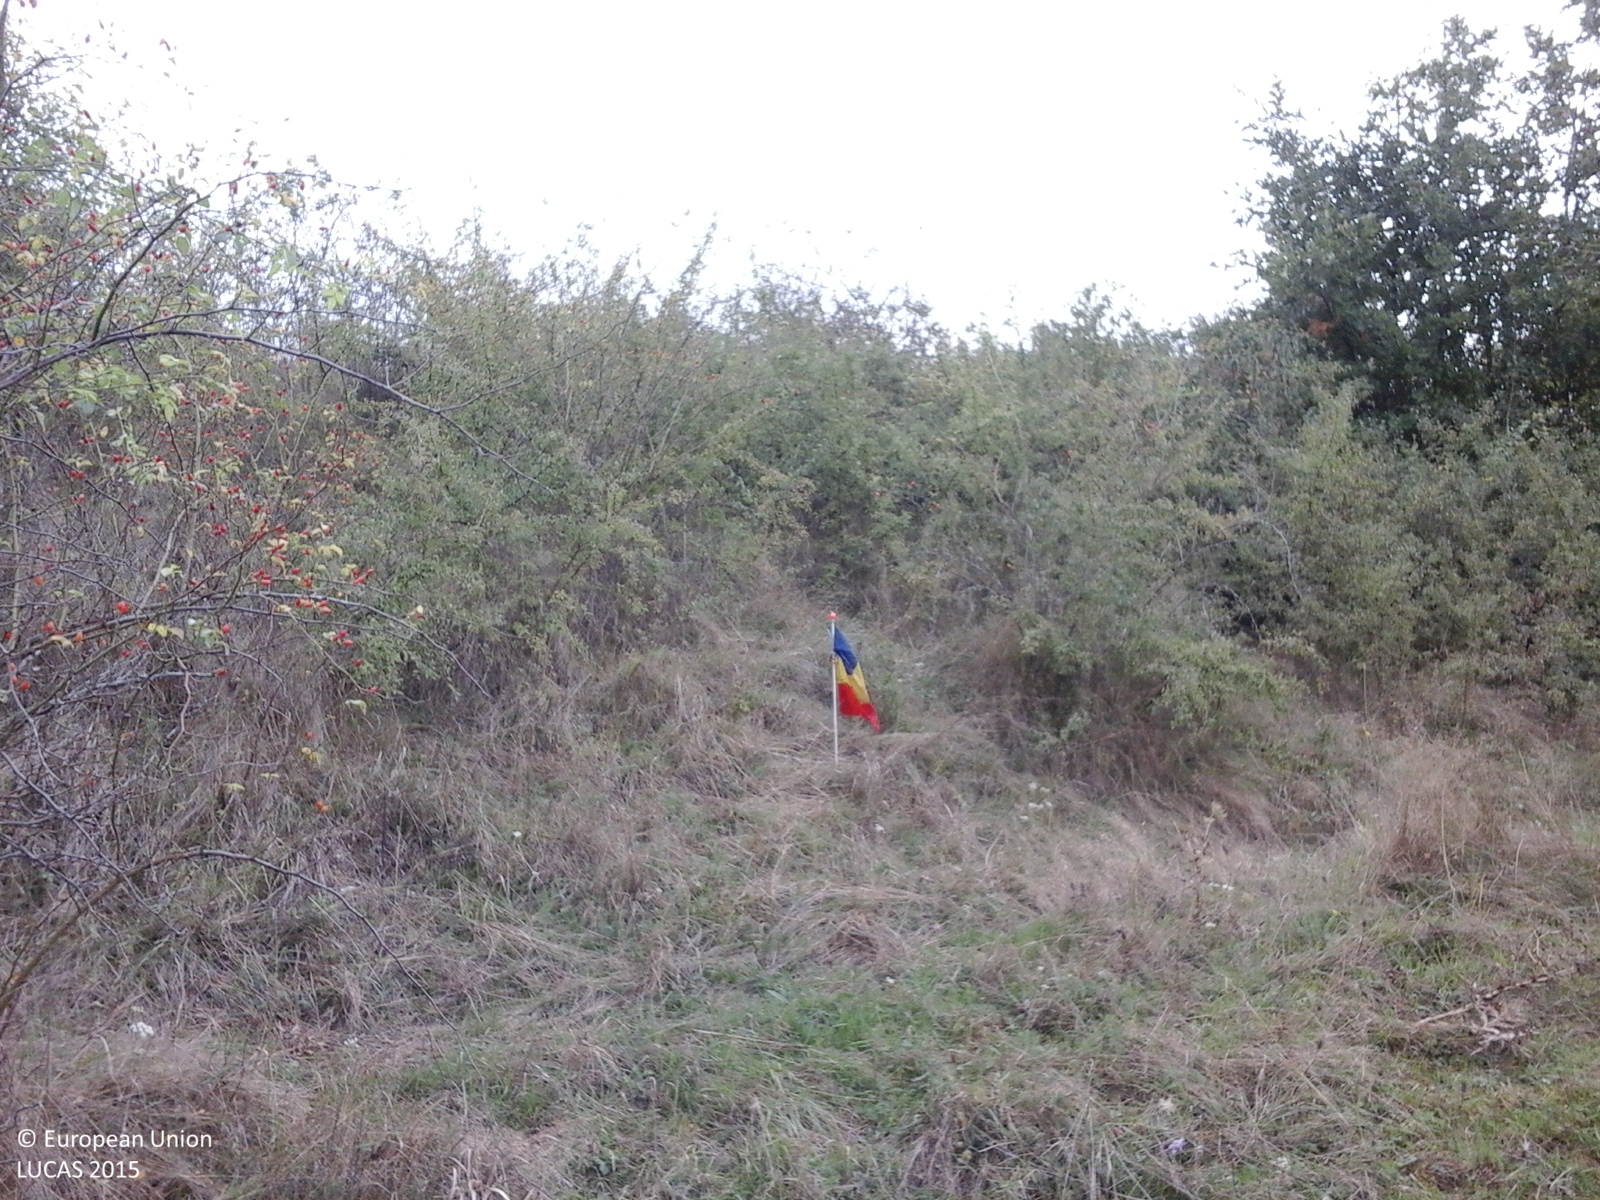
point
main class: Shrubland
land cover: Shrubland with sparse tree cover
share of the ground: > 75 %
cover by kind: herbaceous plants 55 %, shrubs 40 %, broadleaved forest trees 5 %
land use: Fallow land
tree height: < 5 m
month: September
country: RO
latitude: 45.9254
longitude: 22.0209
